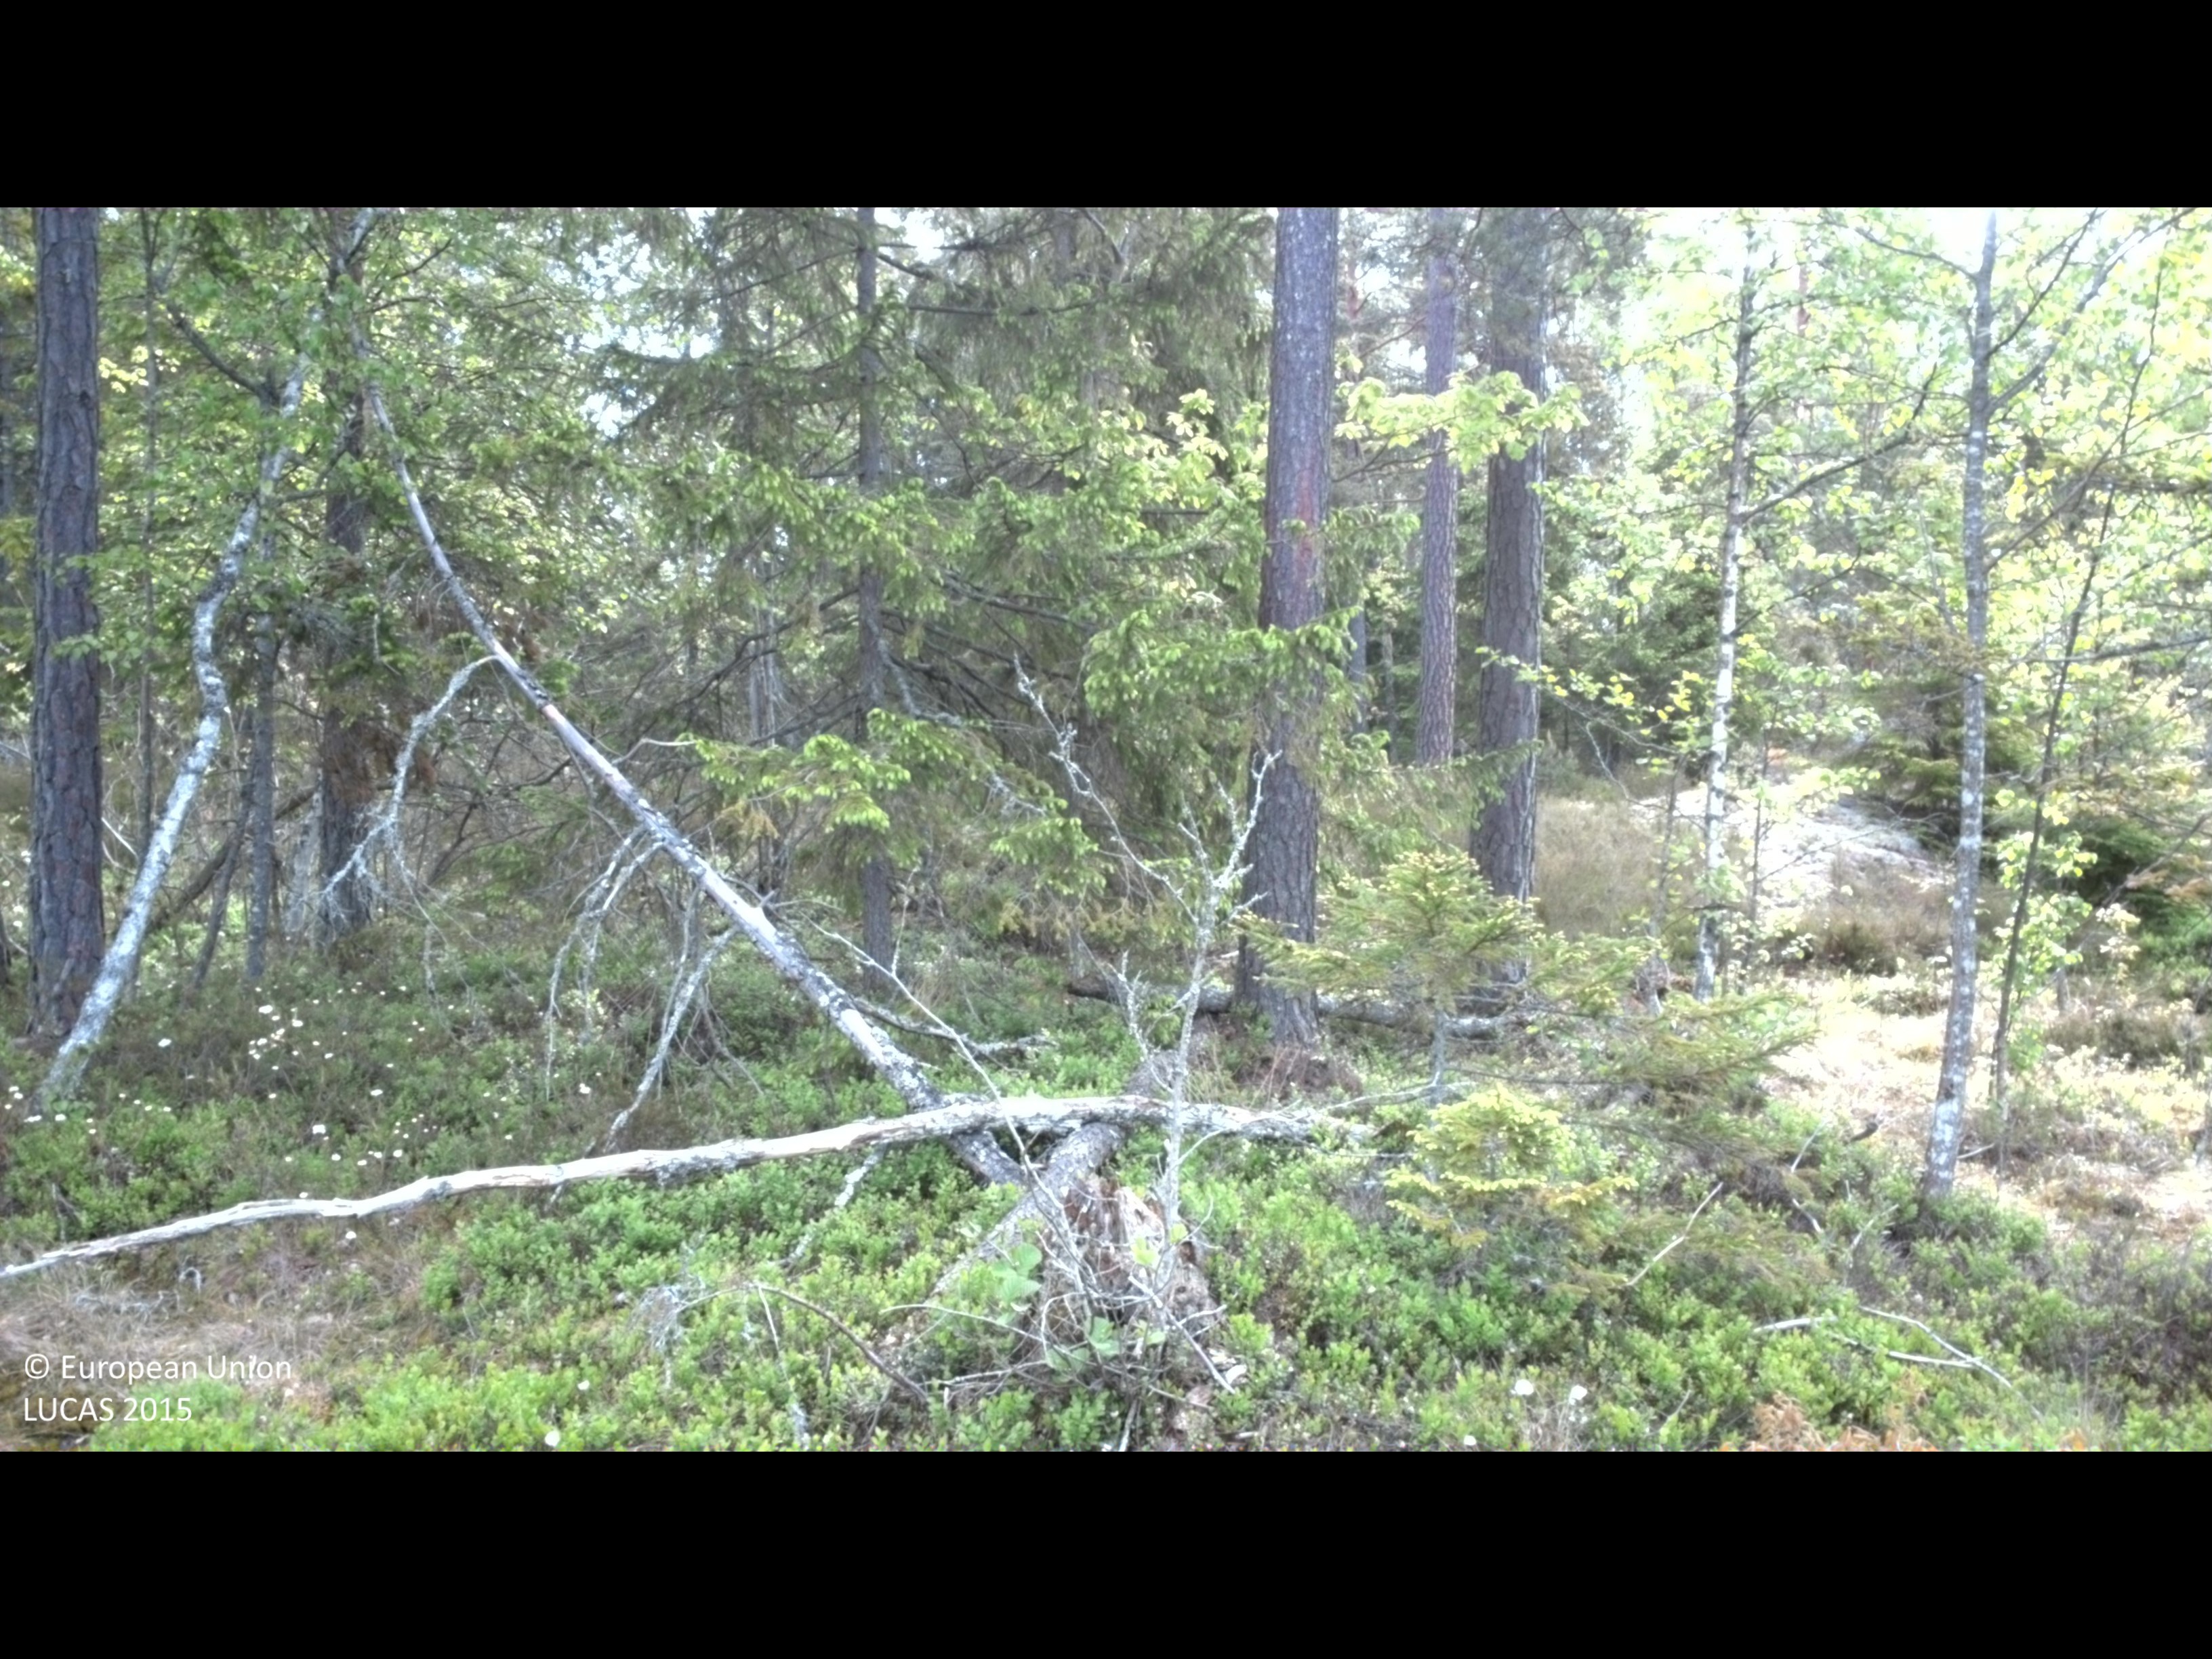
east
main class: Woodland
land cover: Pine dominated mixed woodland
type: boreal forest
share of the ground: > 75 %
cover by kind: coniferous forest trees 60 %, broadleaved forest trees 25 %, shrubs 15 %
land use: Forestry
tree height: > 5 m
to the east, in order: Pine dominated mixed woodland; Spruce dominated mixed woodland; Ditches and canals; Pine dominated mixed woodland; Spruce dominated coniferous woodland; Broadleaved woodland; Grassland without tree/shrub cover
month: May
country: SE
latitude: 57.3242
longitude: 16.4598
